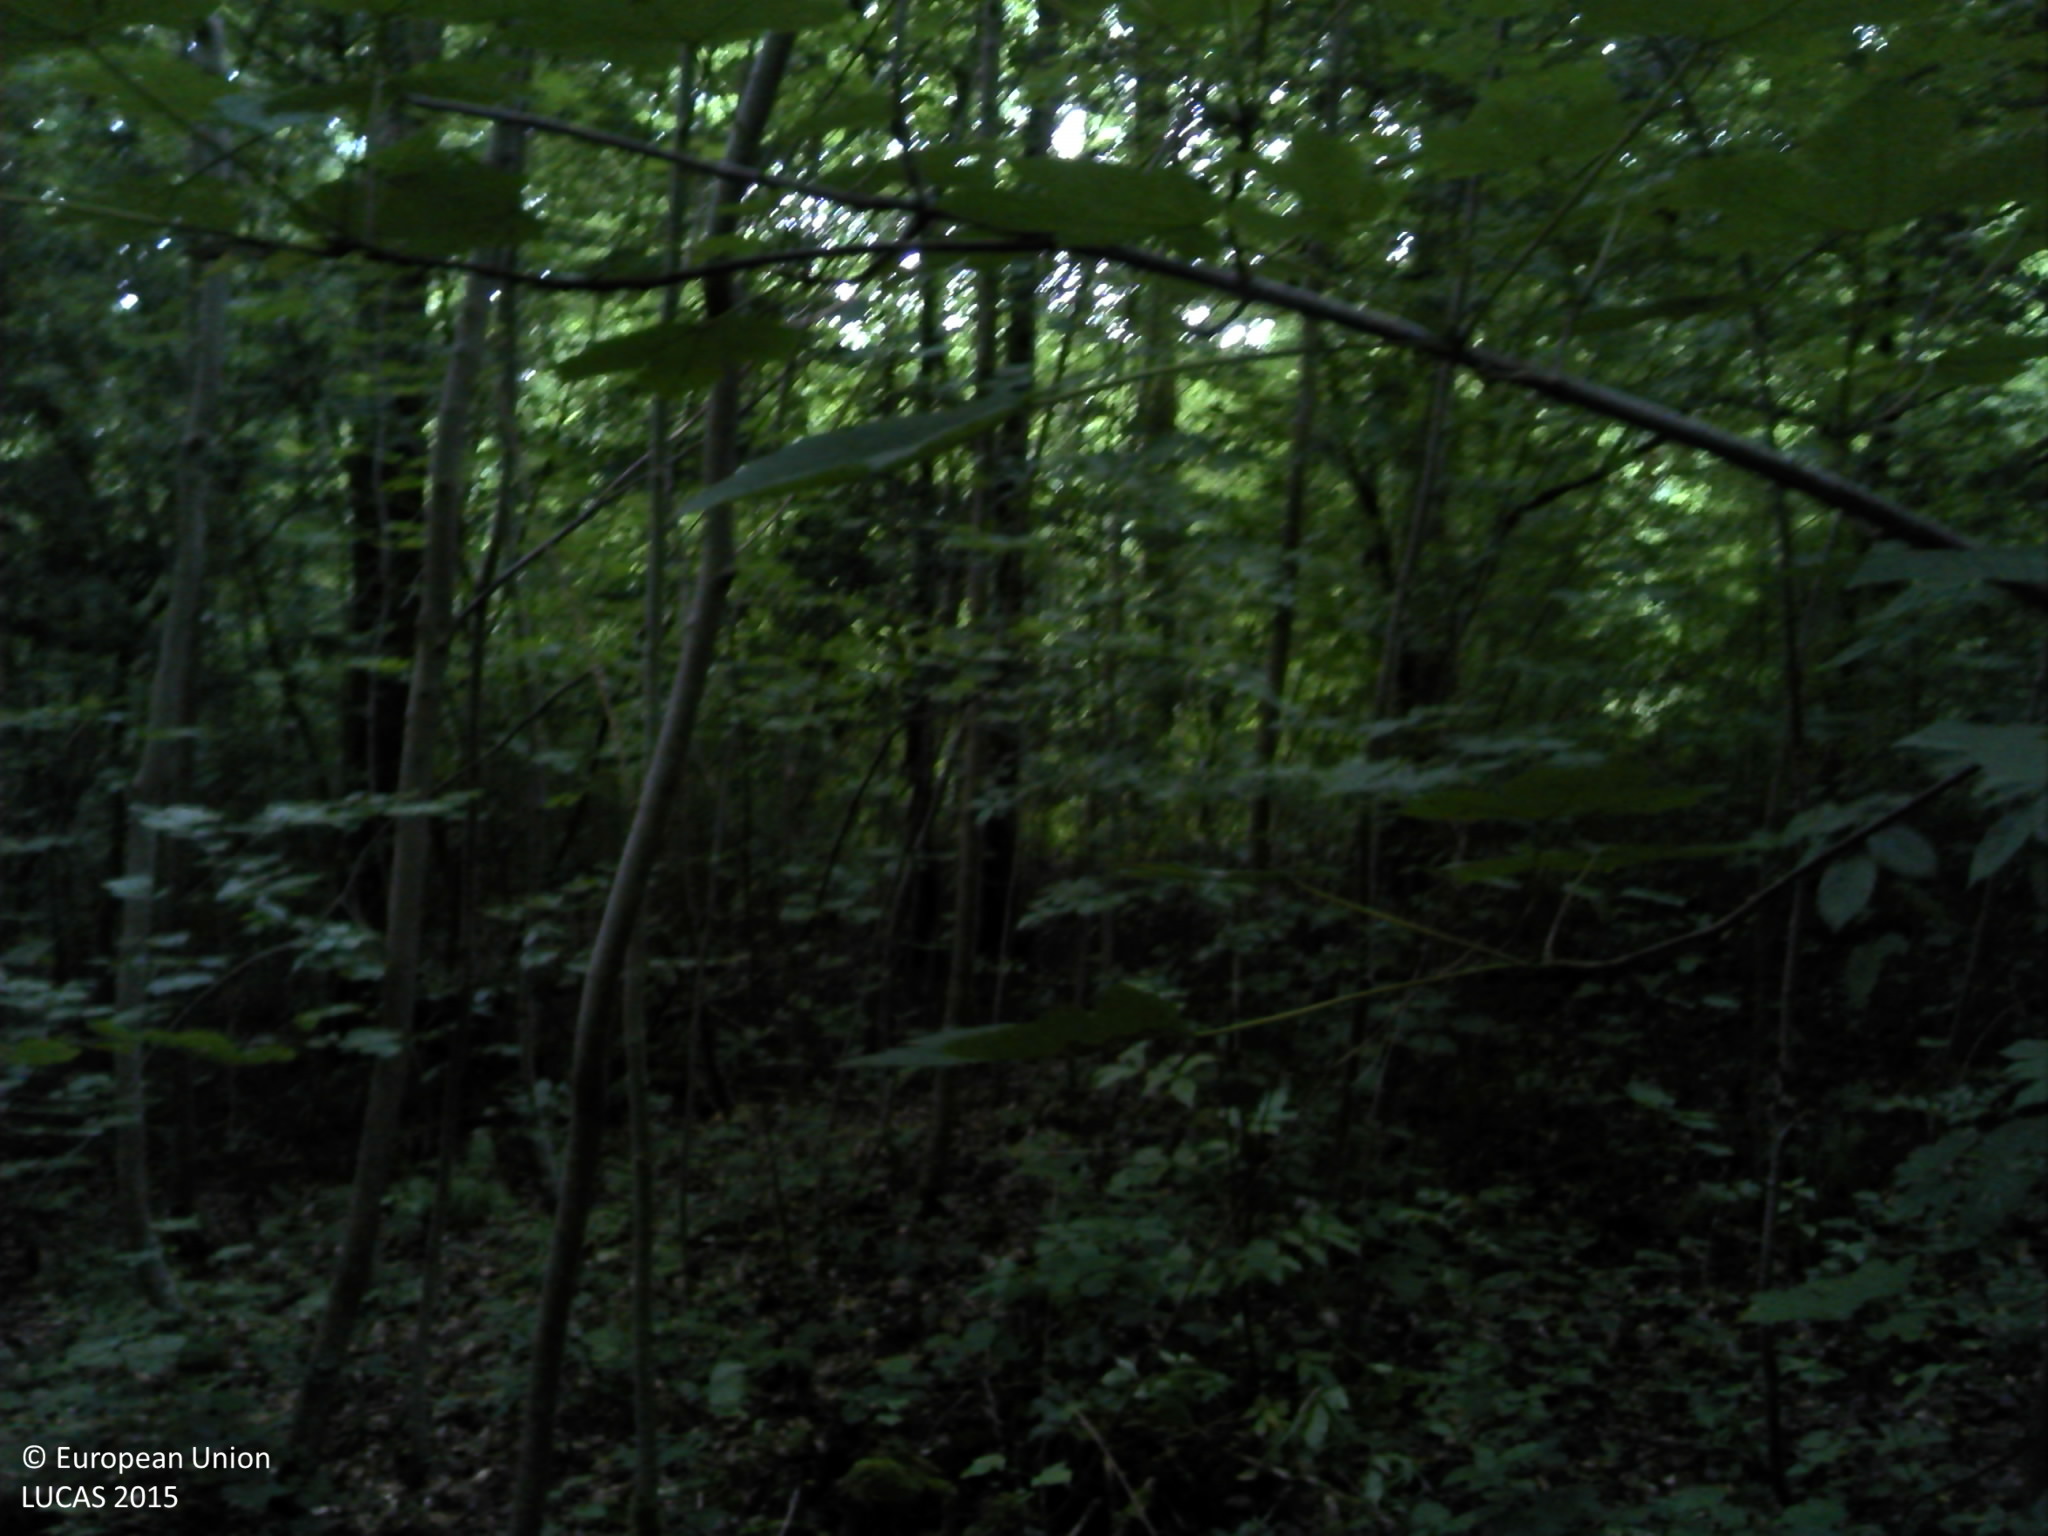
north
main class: Woodland
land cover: Broadleaved woodland
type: beech forest
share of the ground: > 75 %
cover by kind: broadleaved forest trees 80 %, consolidated bare surface 15 %, herbaceous plants 5 %
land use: Forestry
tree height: > 5 m
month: July
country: FR
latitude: 49.6728
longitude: 4.4949
